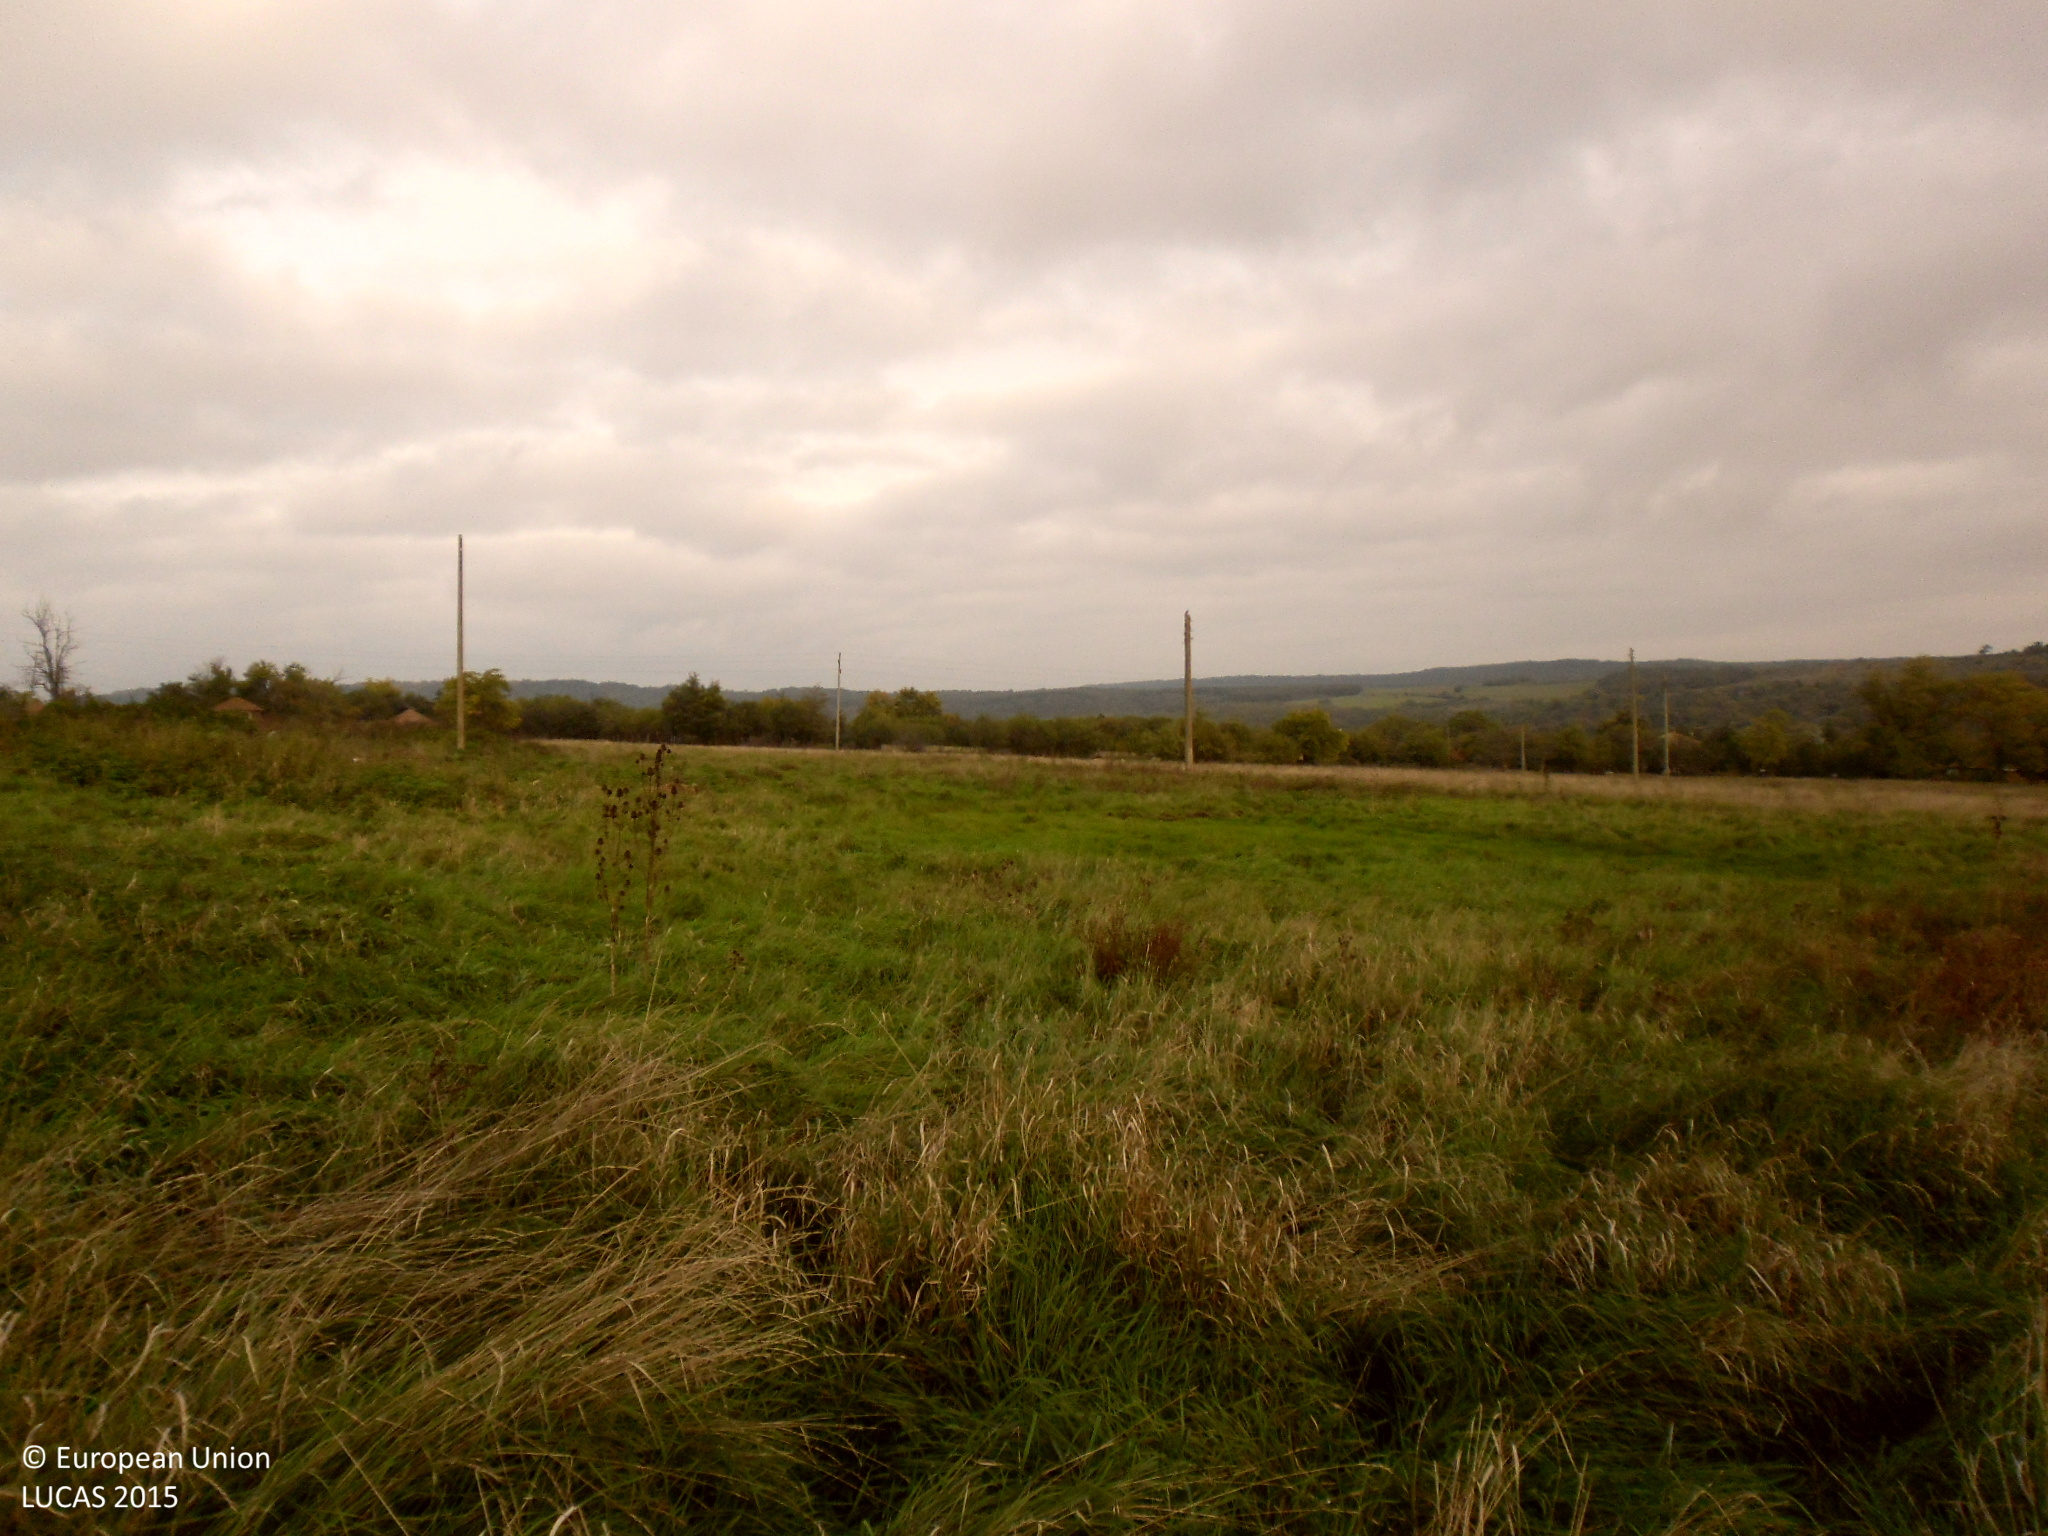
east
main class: Grassland
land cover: Grassland without tree/shrub cover
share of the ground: > 75 %
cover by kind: herbaceous plants 100 %
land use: Agriculture (excluding fallow land and kitchen gardens)
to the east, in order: Grassland without tree/shrub cover; Electric lines; Grassland without tree/shrub cover; Tracks; Electric lines; Grassland without tree/shrub cover
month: October
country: BG
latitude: 43.8308
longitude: 22.4809
